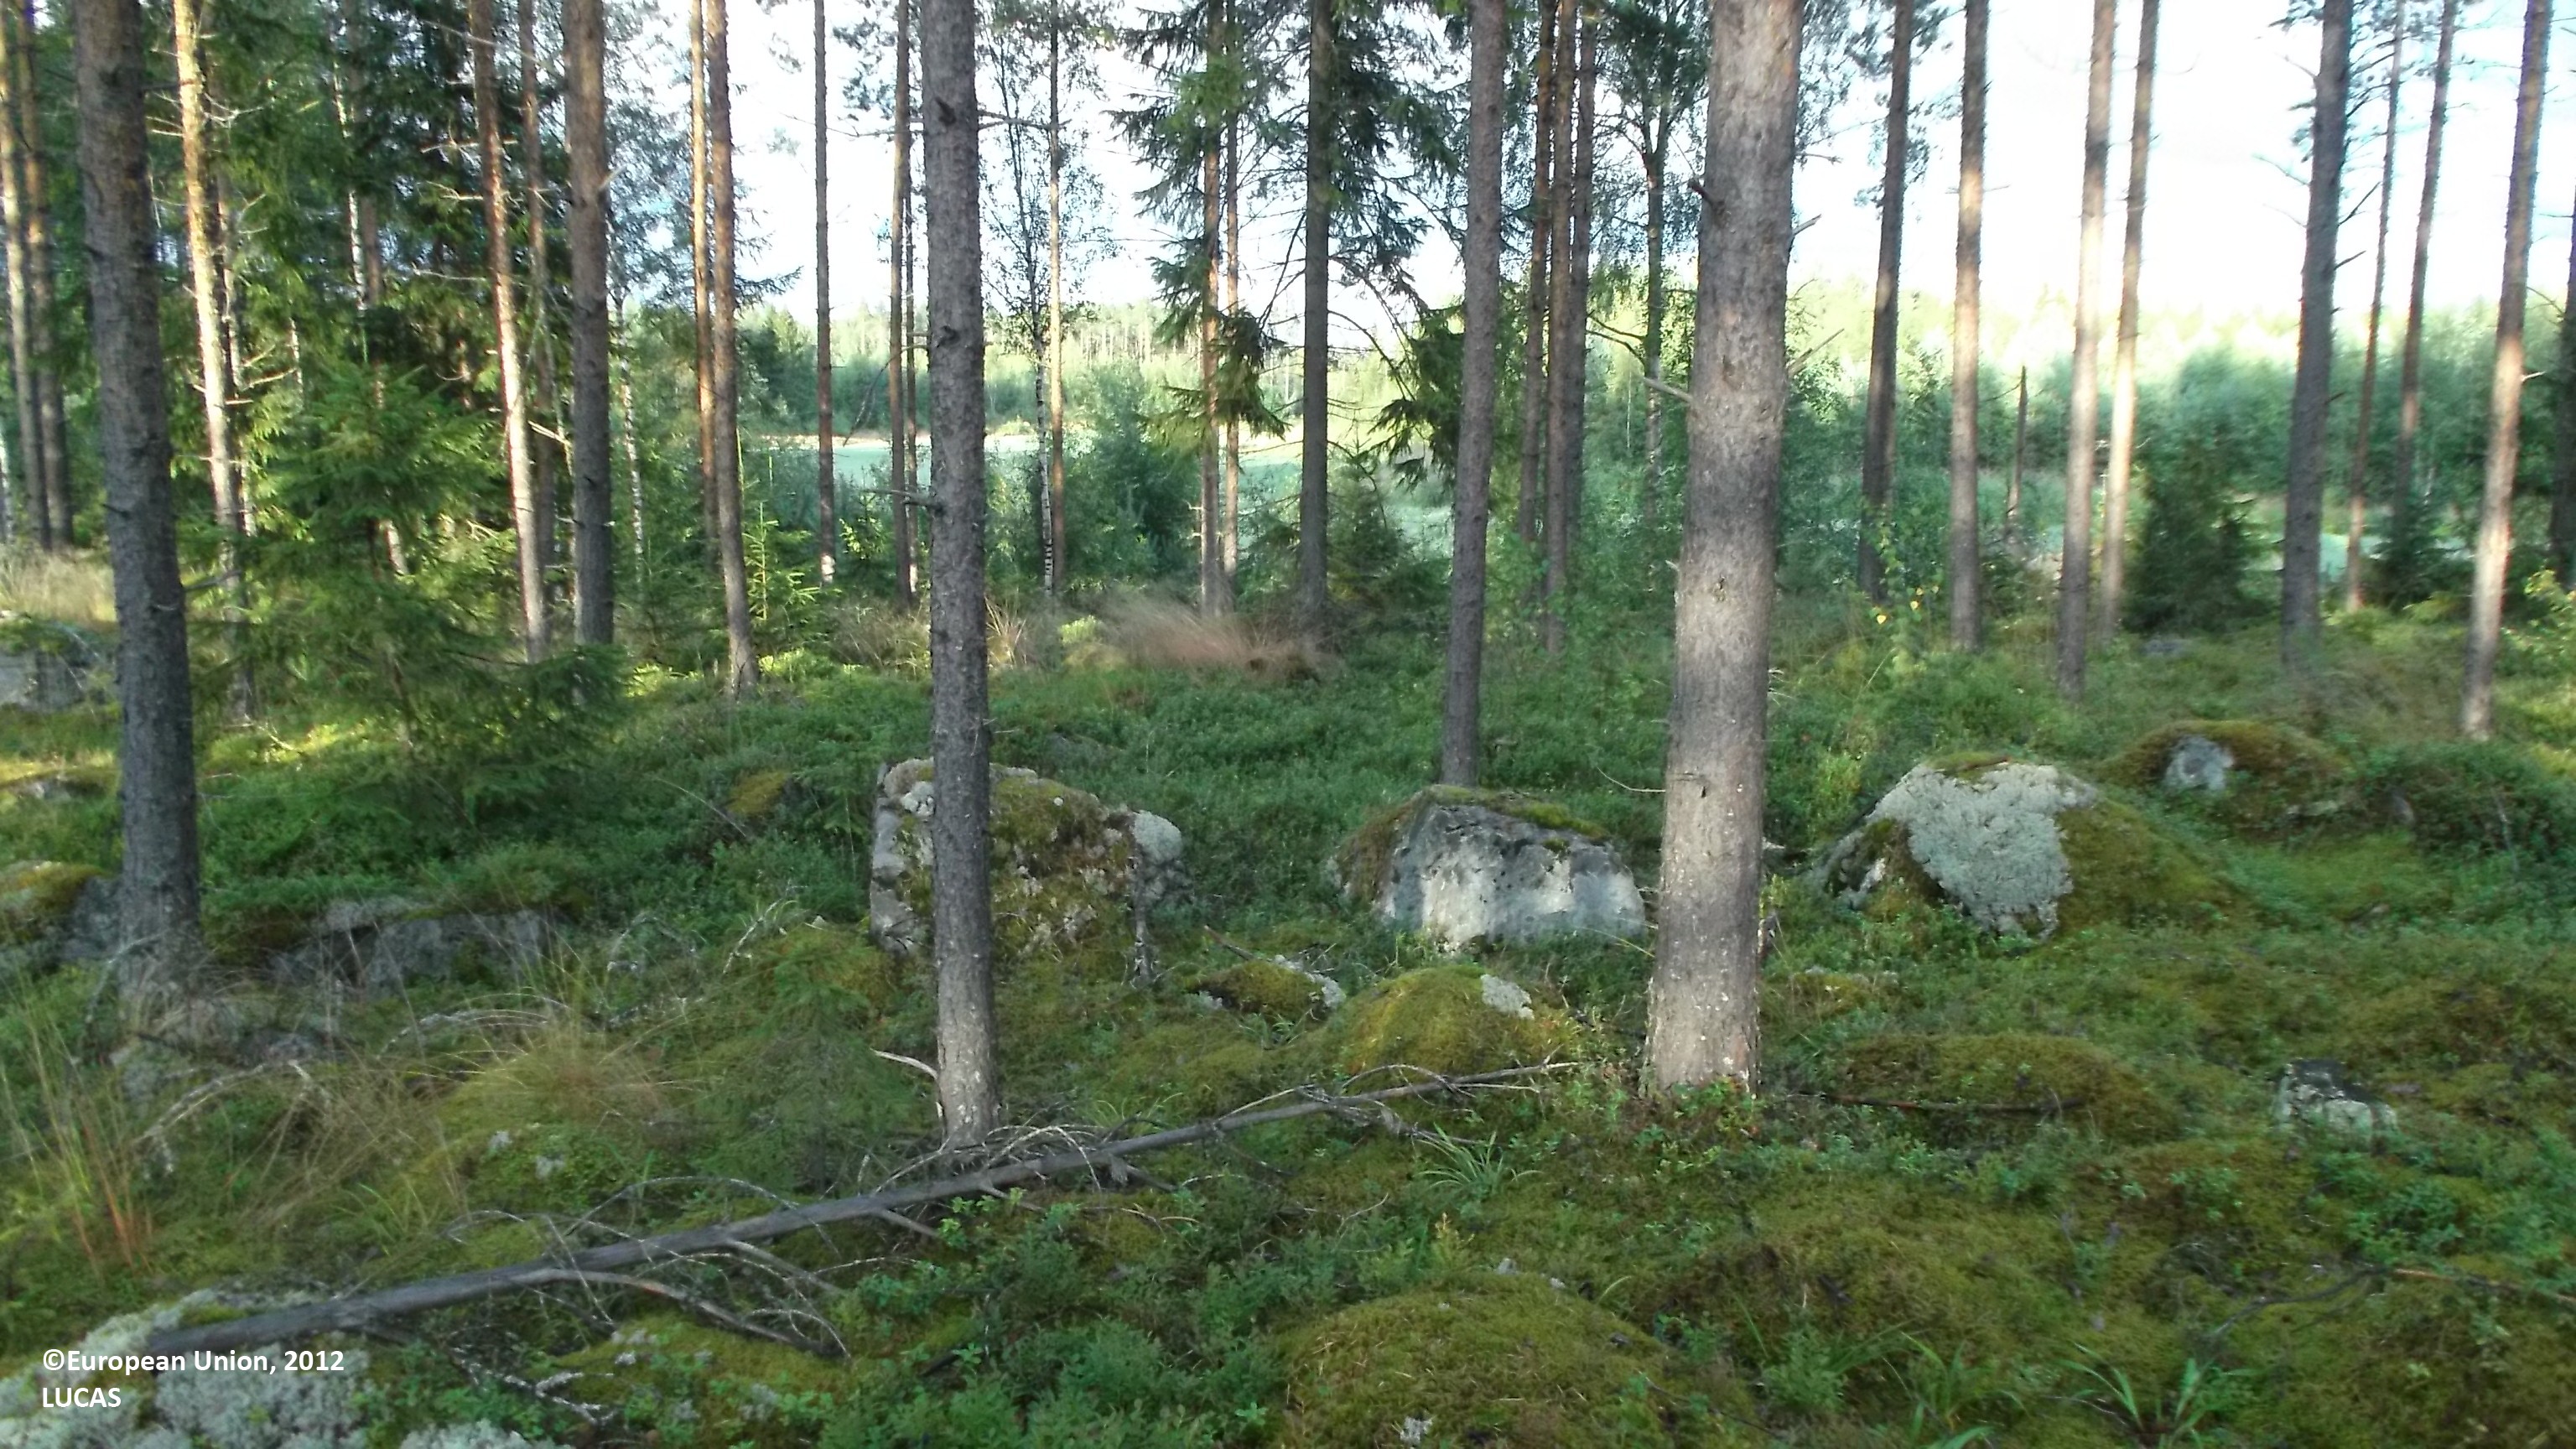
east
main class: Woodland
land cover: Pine dominated coniferous woodland
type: boreal forest
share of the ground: 25 - 50 %
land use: Forestry
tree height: > 5 m
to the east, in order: Pine dominated coniferous woodland; Shrubland without tree cover; Spontaneously vegetated surfaces; Ditches and canals; Grassland without tree/shrub cover; Oats
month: August
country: FI
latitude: 63.8717
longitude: 23.3048
